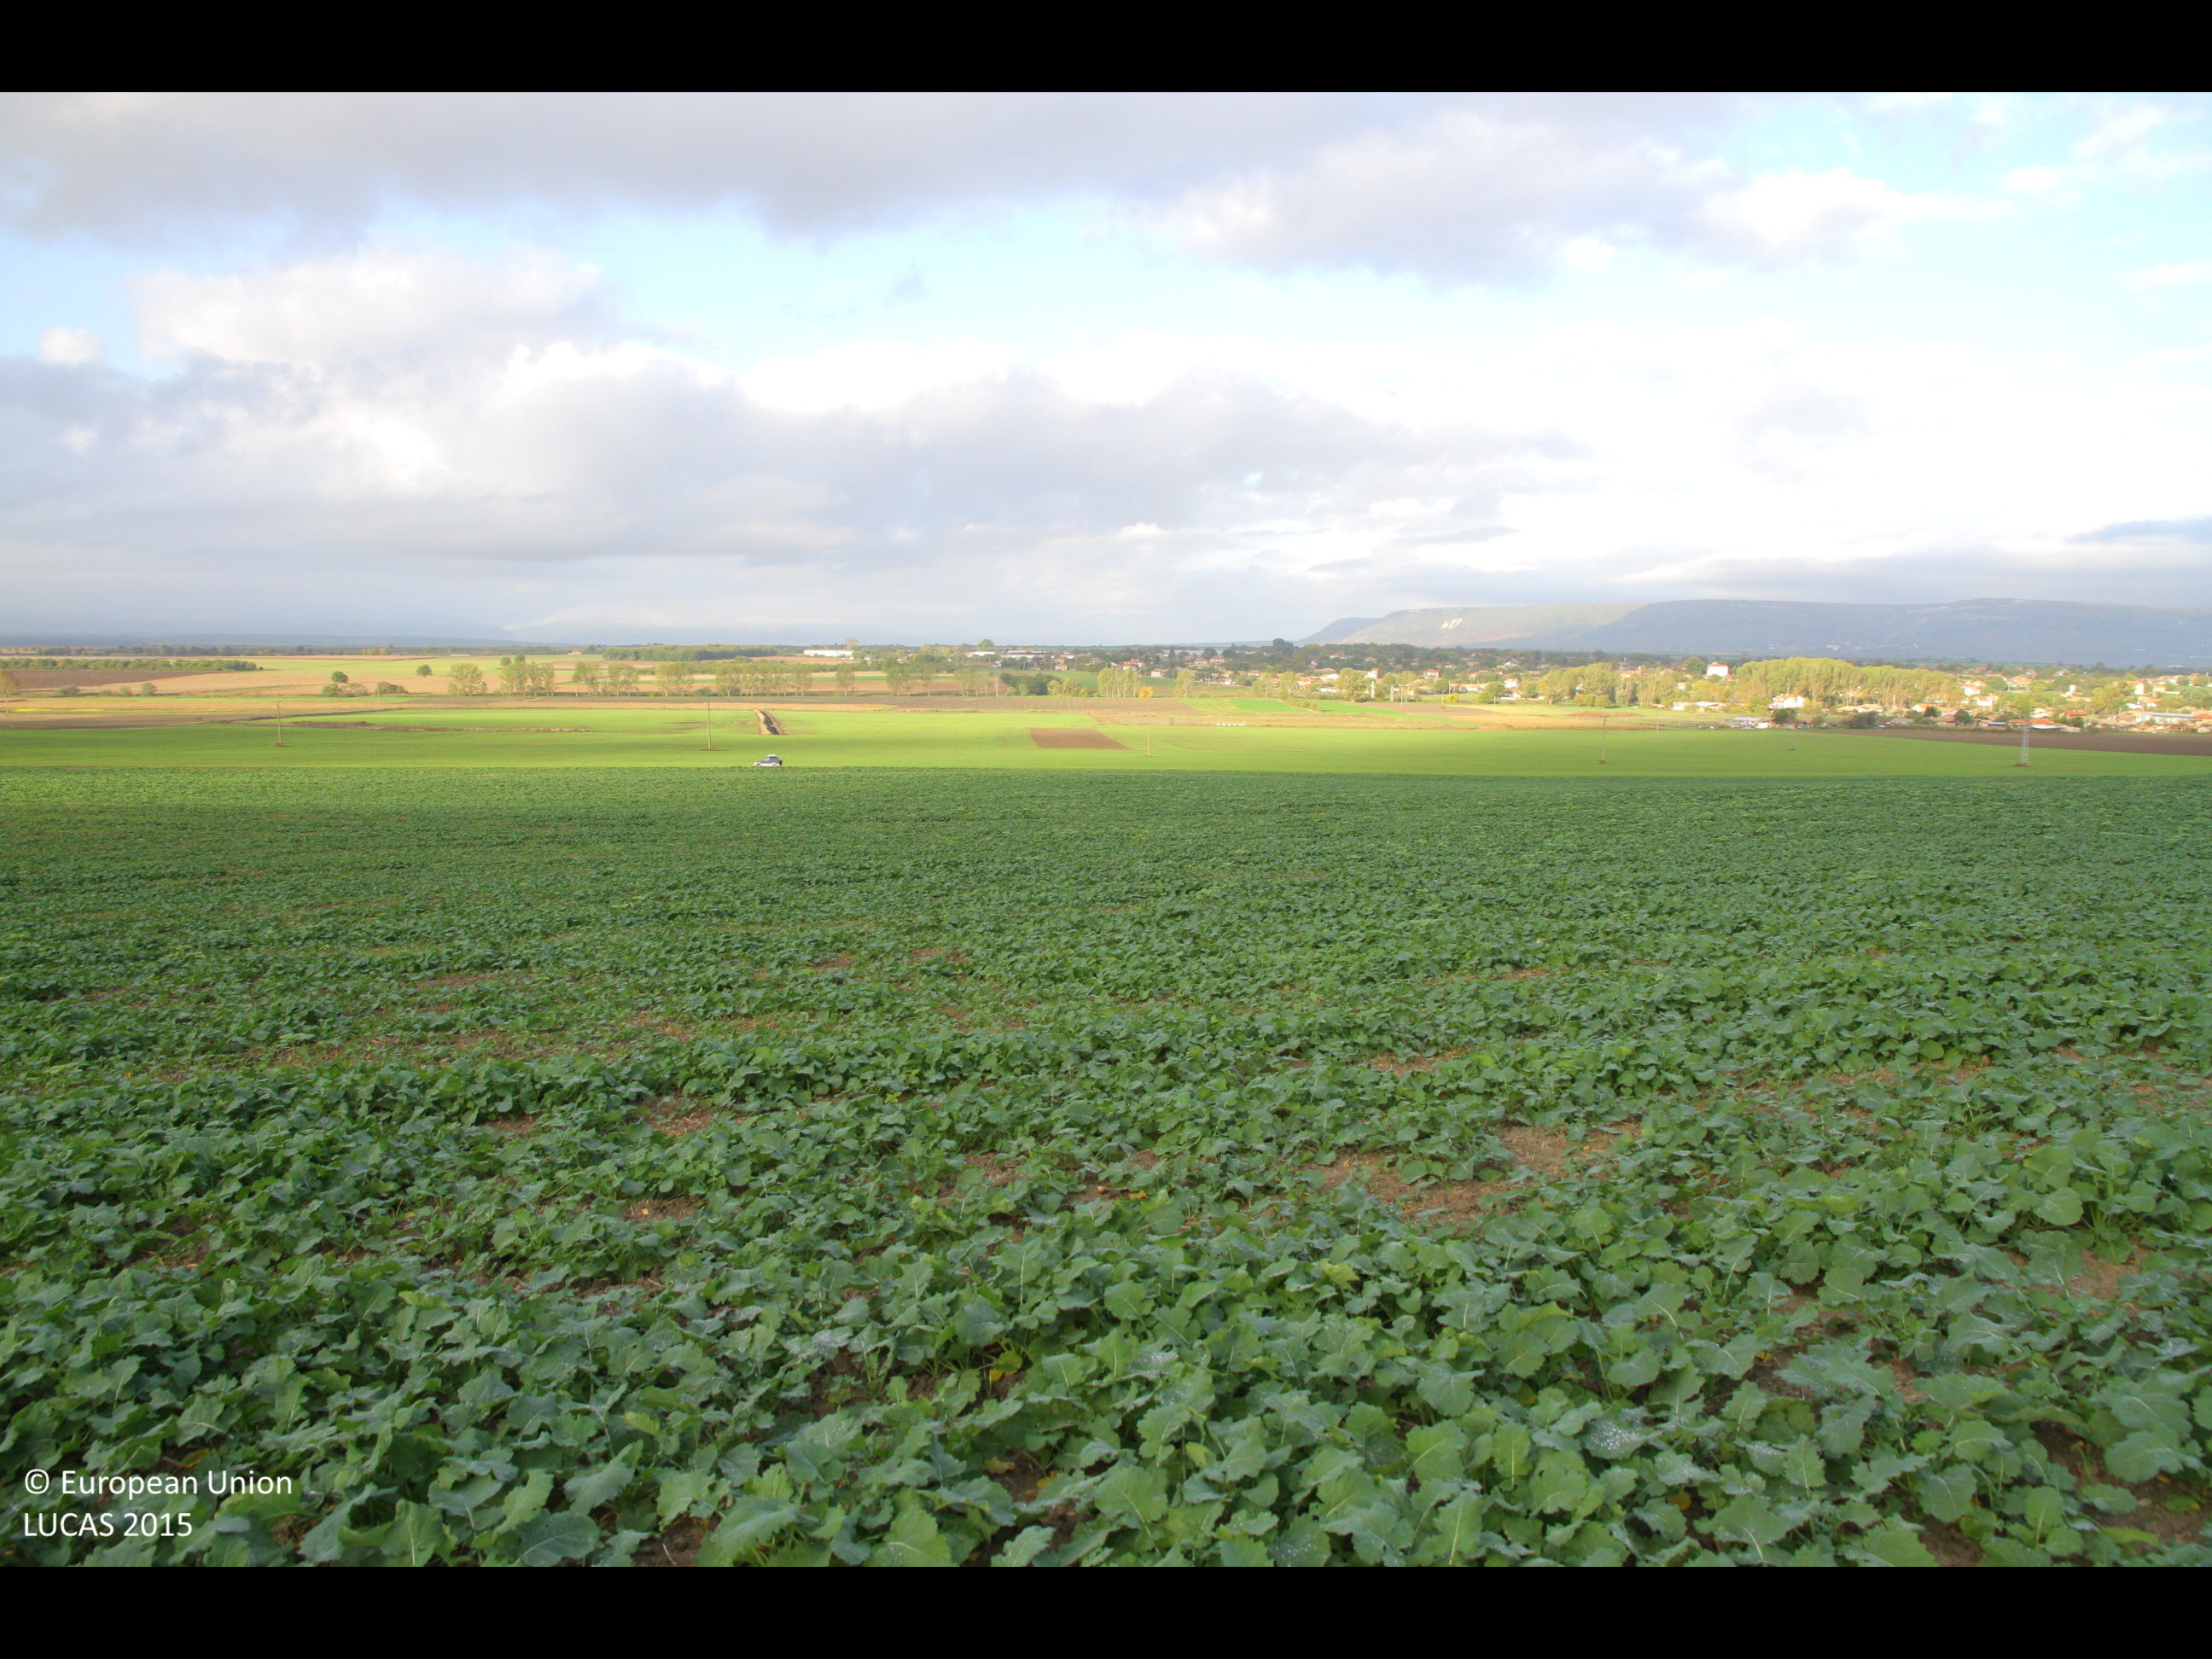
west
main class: Cropland
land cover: Rape and turnip rape
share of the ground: > 75 %
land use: Agriculture (excluding fallow land and kitchen gardens)
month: October
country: BG
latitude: 43.2265
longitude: 27.0190
